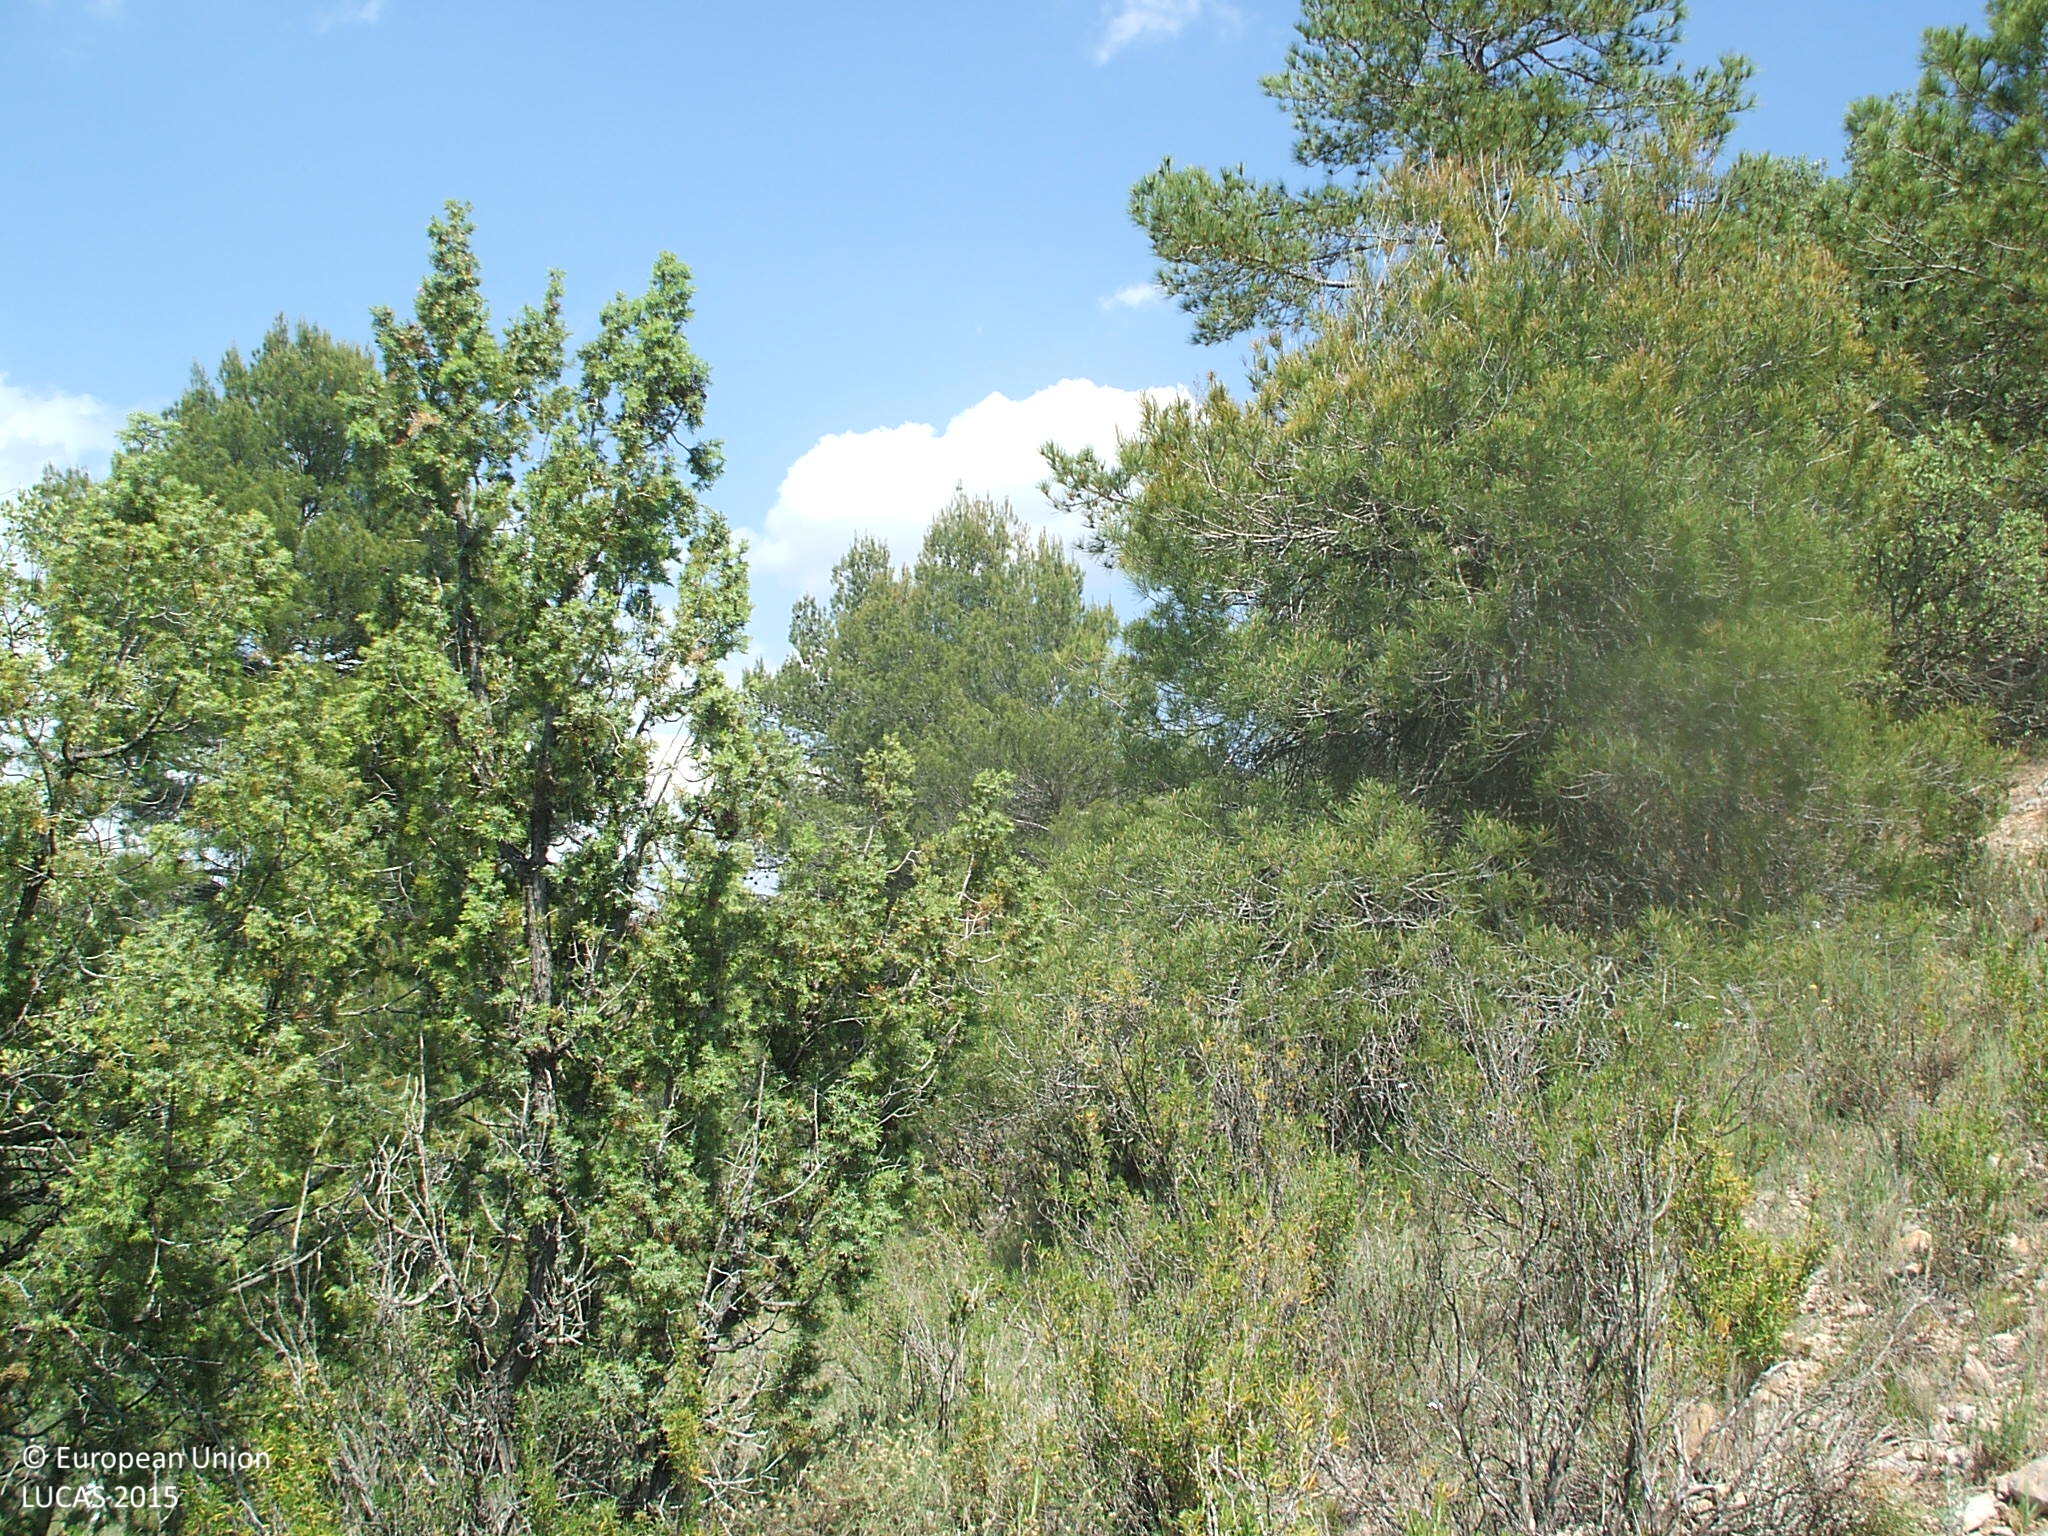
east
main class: Woodland
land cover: Pine dominated mixed woodland
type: coniferous forest of the mediterranean region
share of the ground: 25 - 50 %
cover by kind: consolidated bare surface 50 %, shrubs 20 %, coniferous forest trees 15 %, broadleaved forest trees 15 %
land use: Semi-natural and natural areas not in use
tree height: > 5 m
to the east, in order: Pine dominated mixed woodland; Pine dominated coniferous woodland; Fences; Tracks
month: May
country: ES
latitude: 40.7408
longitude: -0.1575
